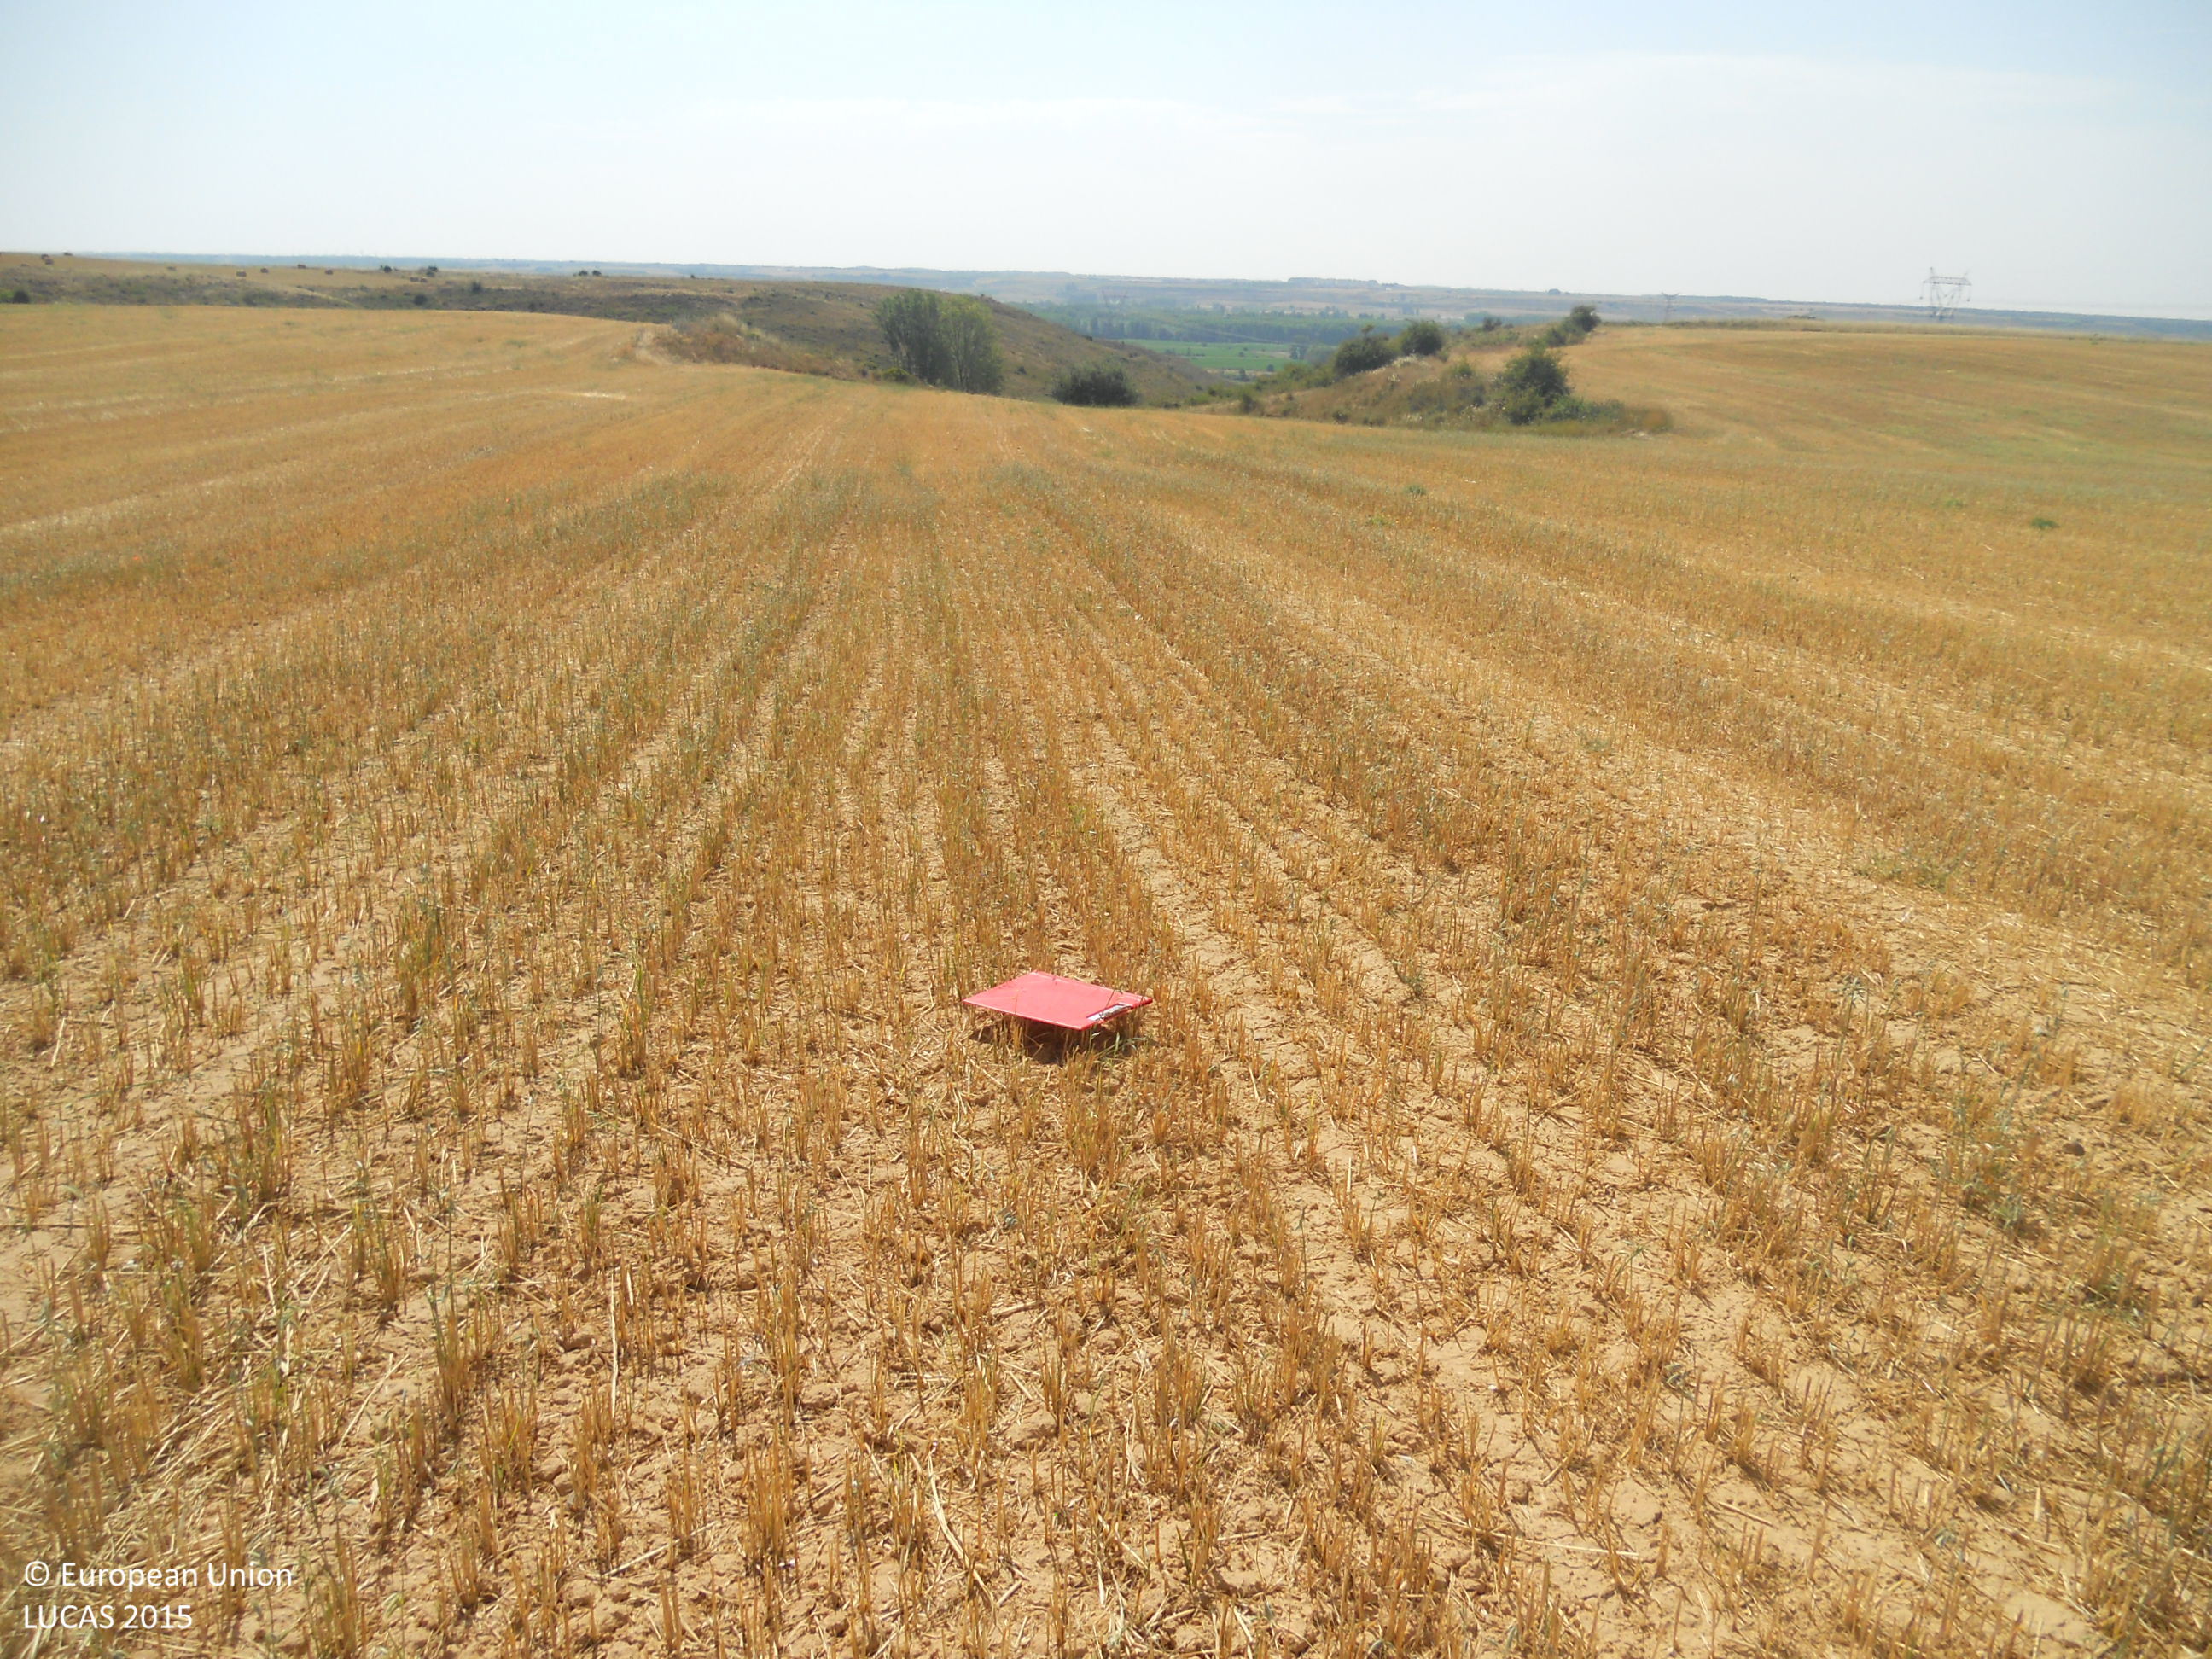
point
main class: Cropland
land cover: Oats
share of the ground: < 10 %
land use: Agriculture (excluding fallow land and kitchen gardens)
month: July
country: ES
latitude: 42.5616
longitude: -5.3295
